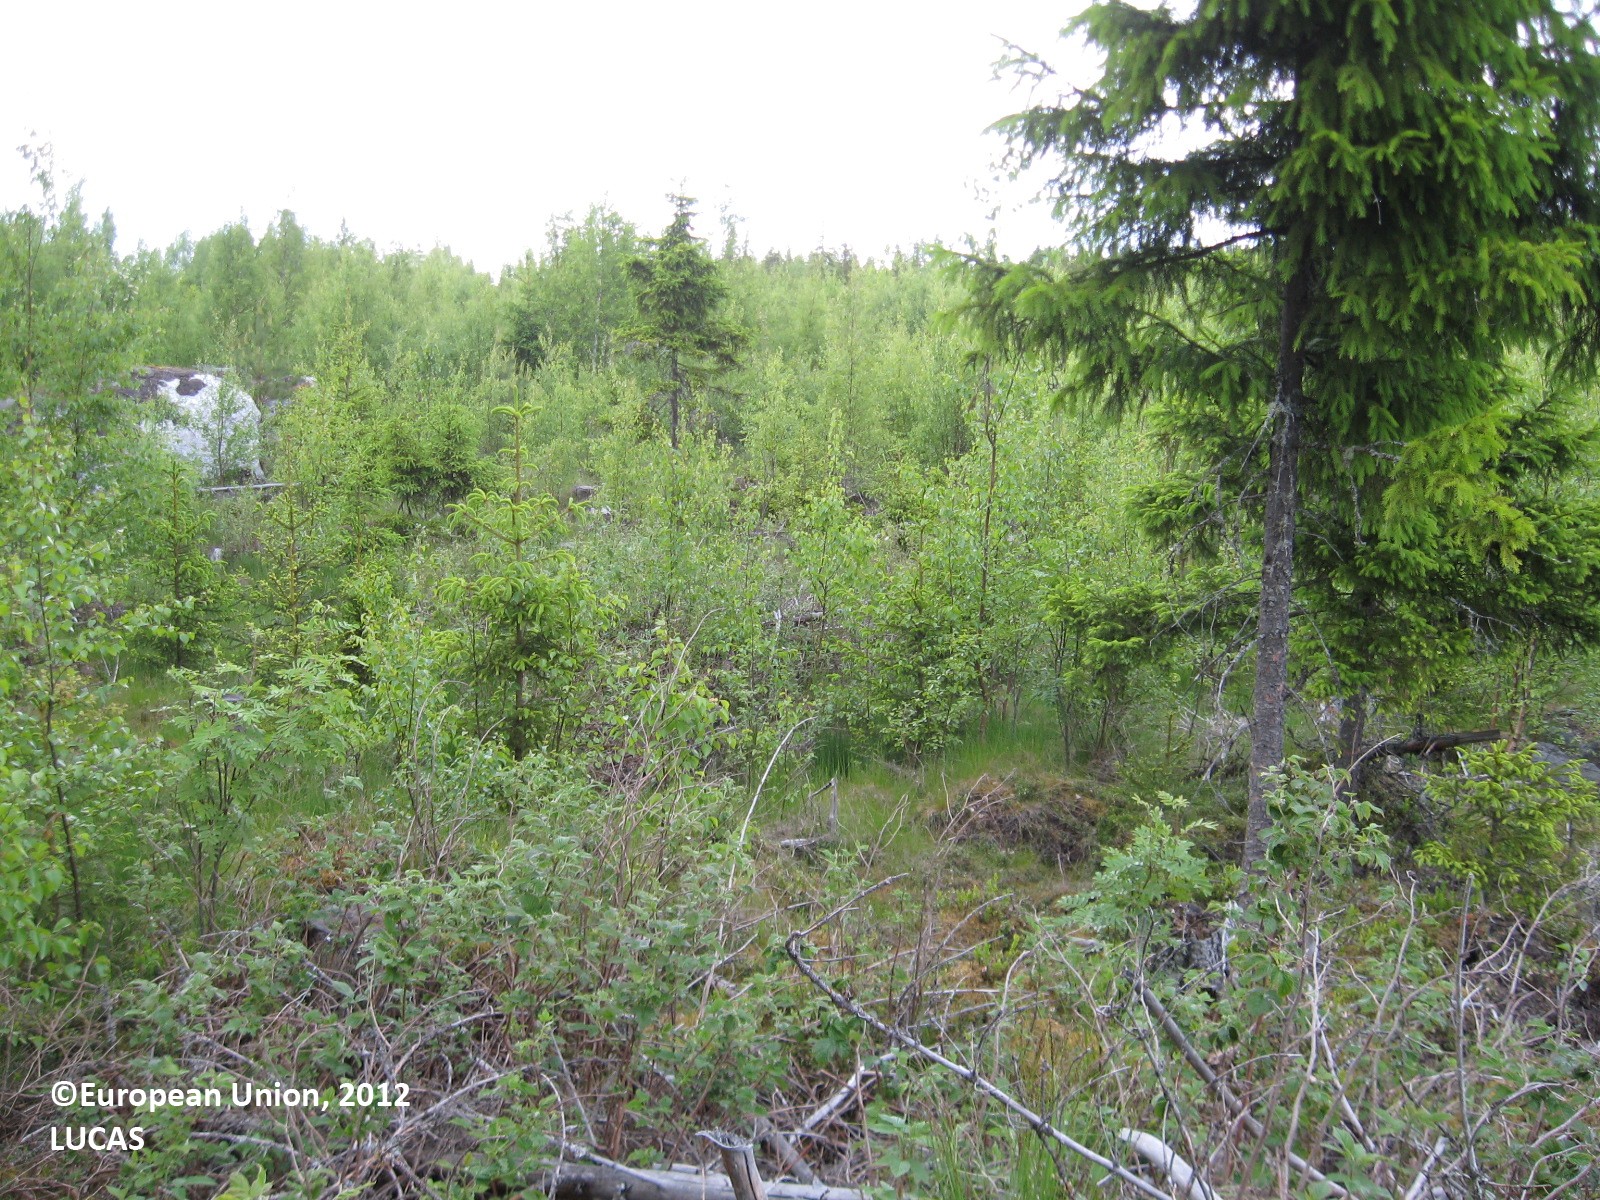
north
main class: Woodland
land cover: Spruce dominated mixed woodland
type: boreal forest
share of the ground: > 75 %
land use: Forestry
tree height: < 5 m
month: June
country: FI
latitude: 63.0324
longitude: 21.9231
